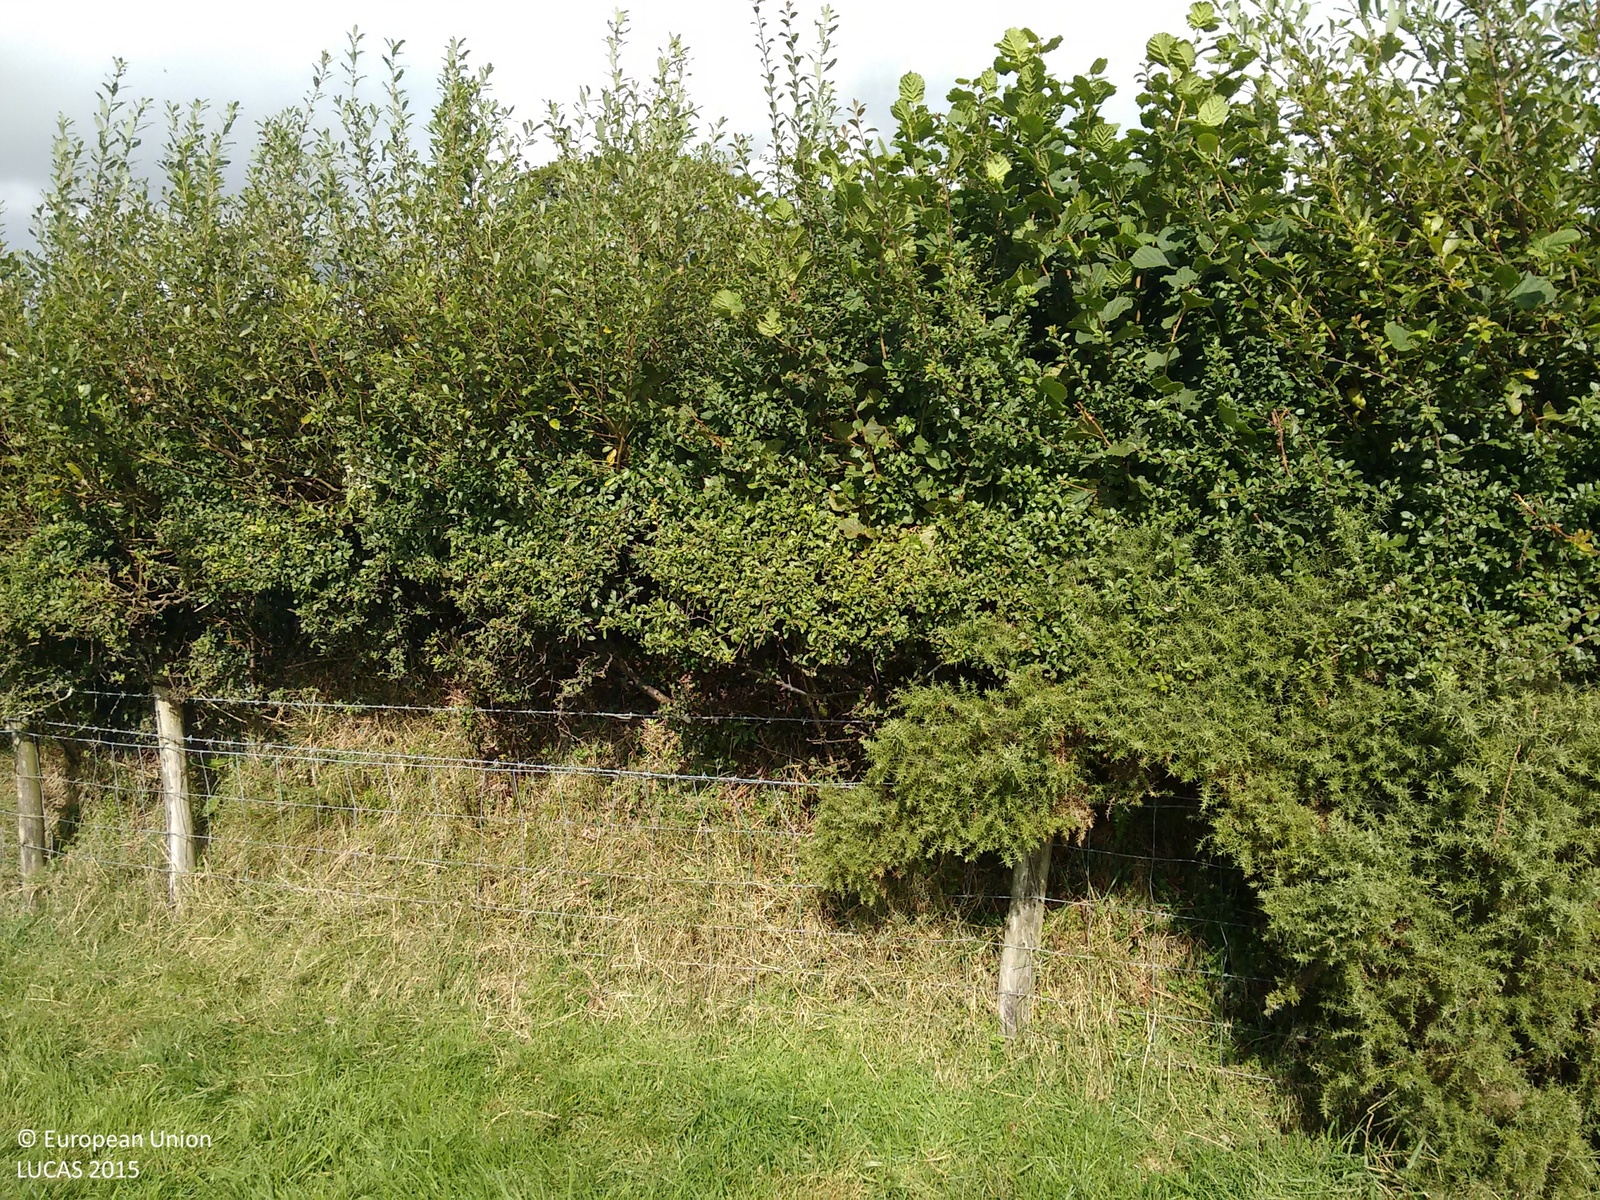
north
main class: Grassland
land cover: Grassland without tree/shrub cover
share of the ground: > 75 %
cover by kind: herbaceous plants 100 %
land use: Agriculture (excluding fallow land and kitchen gardens)
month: September
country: GB
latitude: 50.6730
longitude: -4.0903
